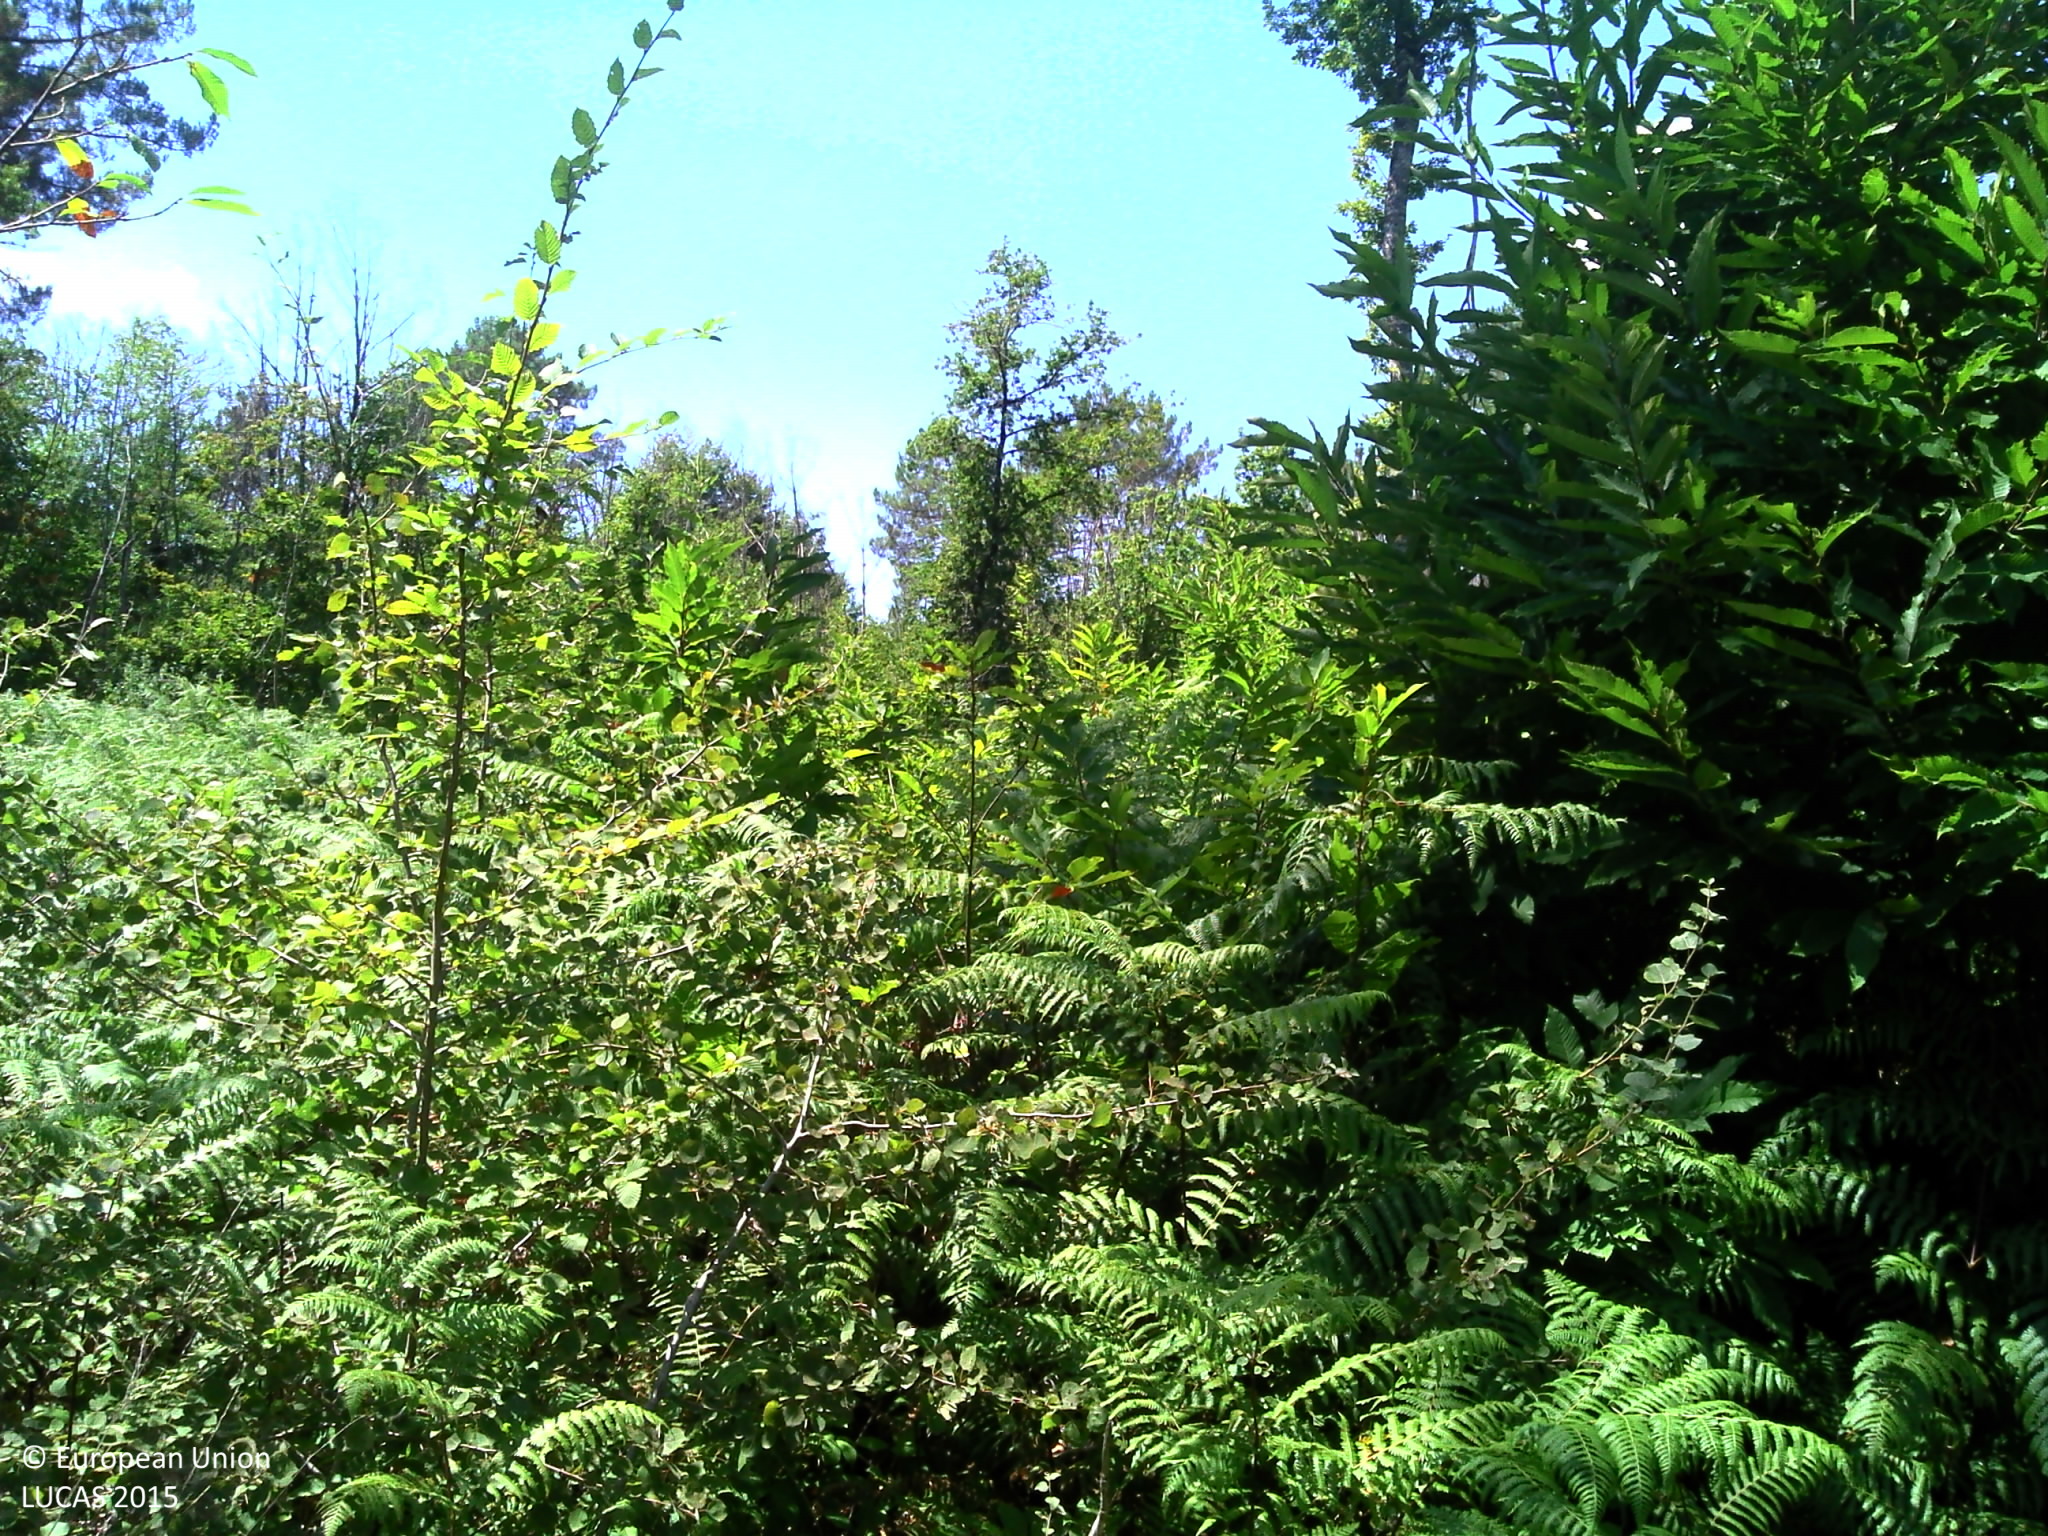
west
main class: Woodland
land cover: Pine dominated mixed woodland
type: coniferous forest of the mediterranean region
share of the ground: 25 - 50 %
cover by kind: herbaceous plants 40 %, broadleaved forest trees 30 %, shrubs 20 %, coniferous forest trees 10 %
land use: Forestry
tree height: < 5 m
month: August
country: FR
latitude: 45.2541
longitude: 0.6749
